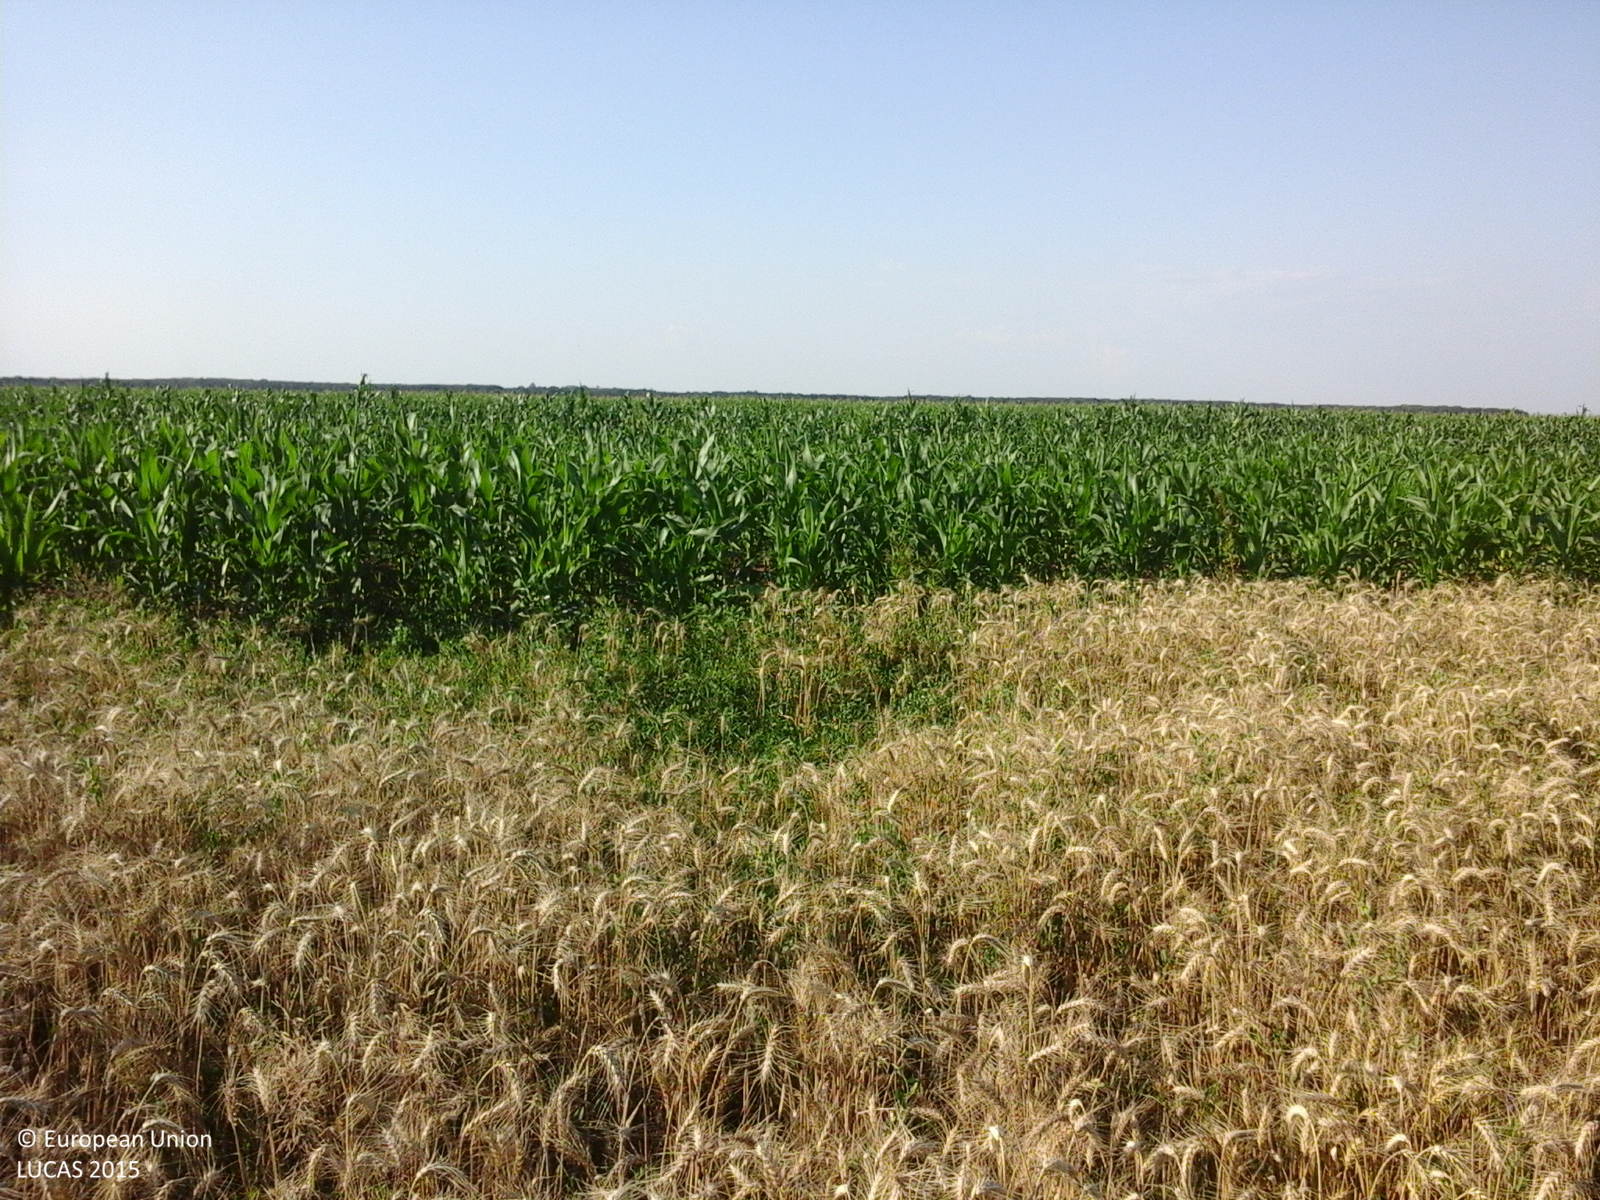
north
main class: Cropland
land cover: Common wheat
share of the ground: > 75 %
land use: Agriculture (excluding fallow land and kitchen gardens)
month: July
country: RO
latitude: 44.3210
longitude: 24.4504
